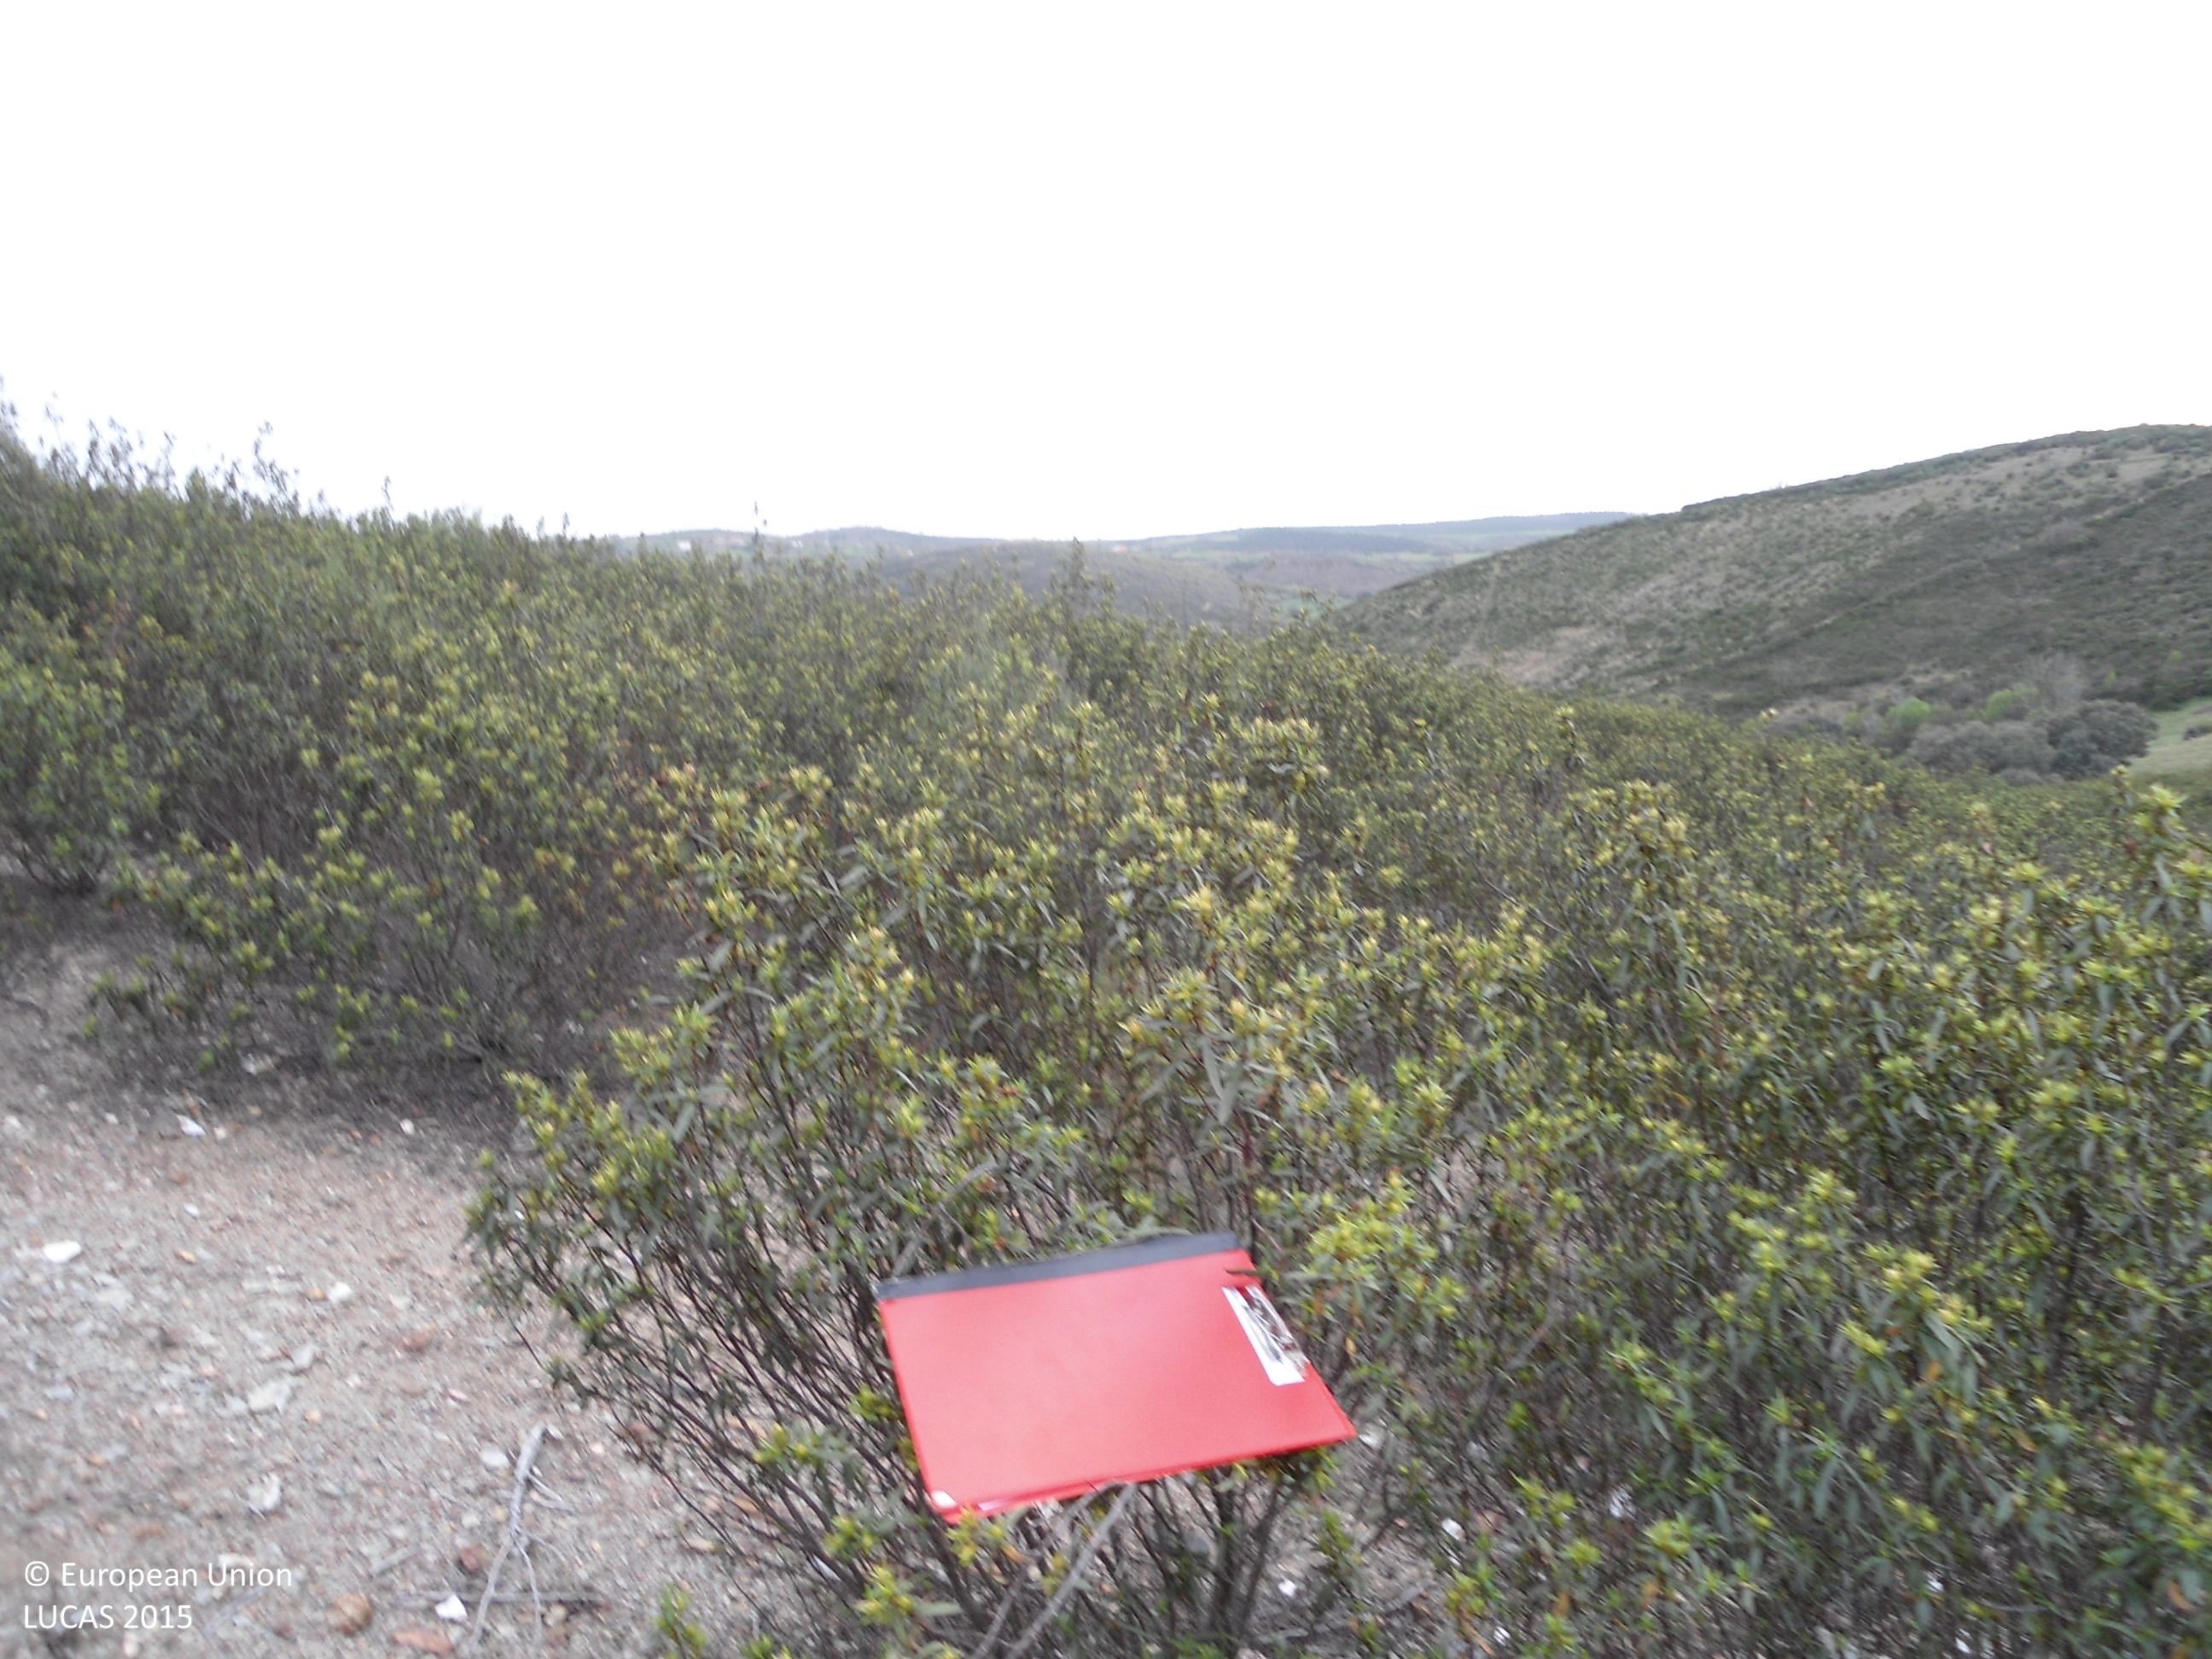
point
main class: Shrubland
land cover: Shrubland without tree cover
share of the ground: > 75 %
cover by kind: shrubs 95 %, consolidated bare surface 5 %
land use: Semi-natural and natural areas not in use
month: April
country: ES
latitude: 41.7893
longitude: -6.4836
